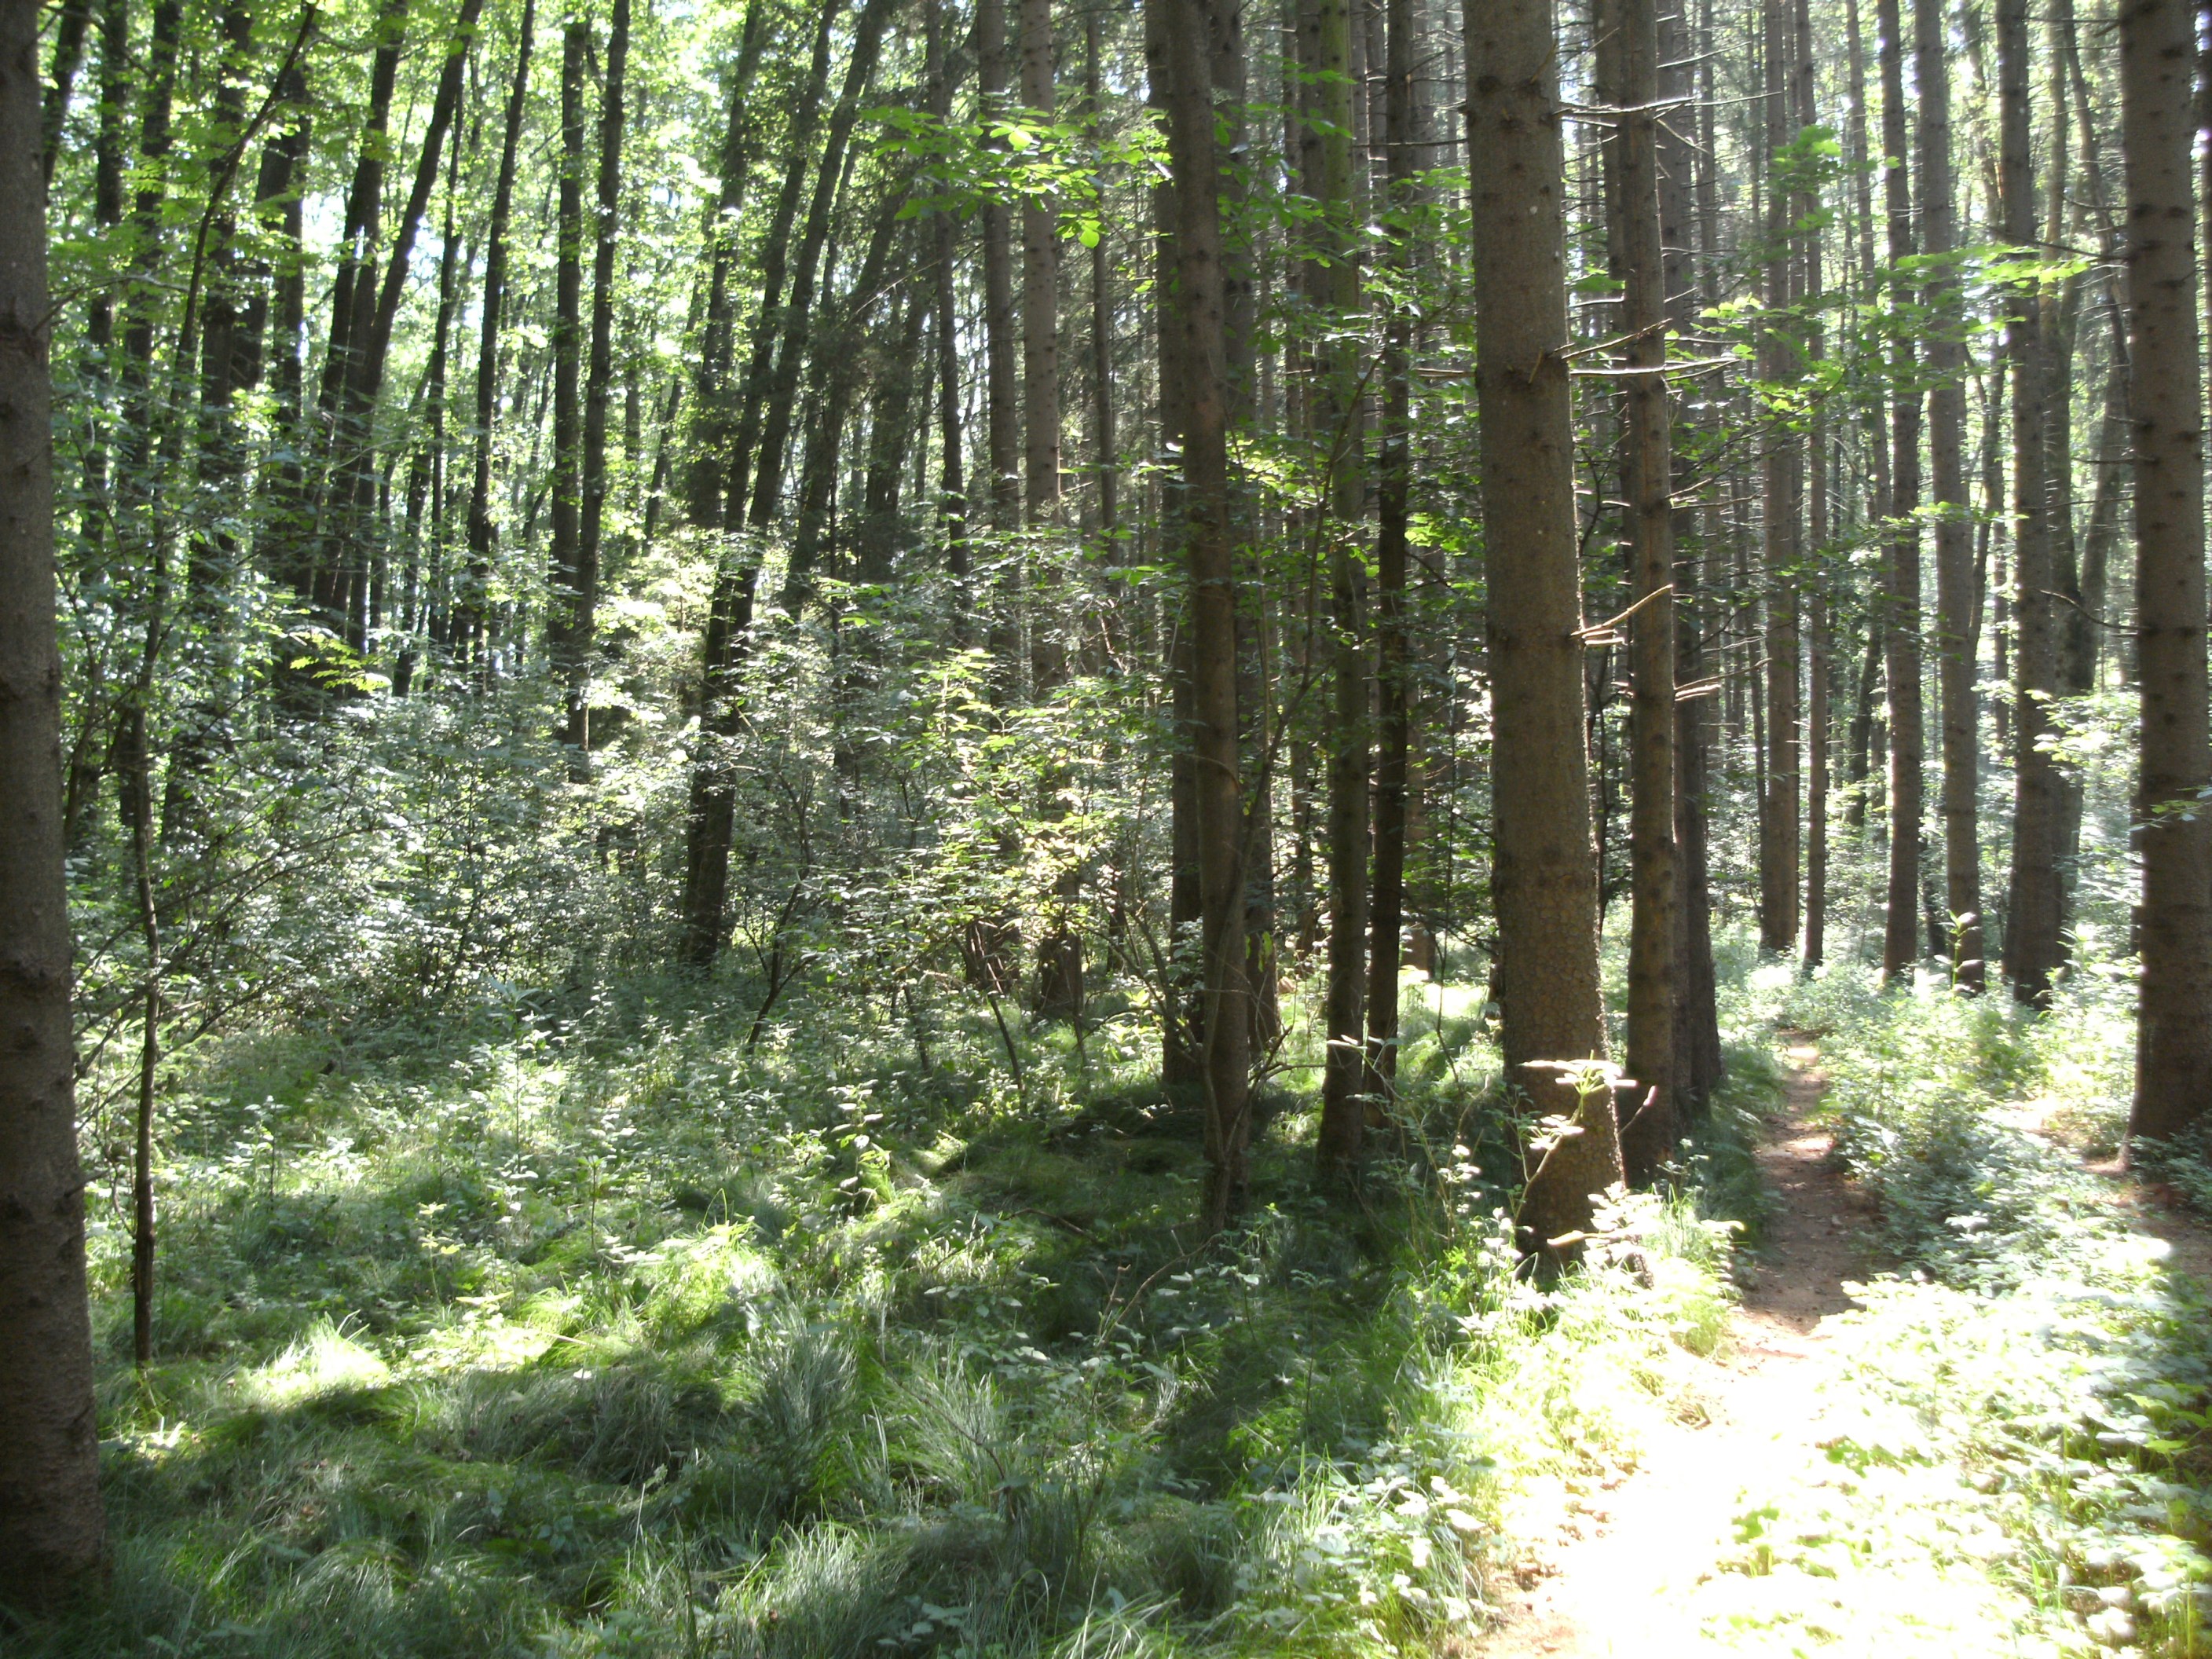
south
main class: Woodland
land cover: Spruce dominated mixed woodland
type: mire and swamp forests
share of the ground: > 75 %
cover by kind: coniferous forest trees 40 %, broadleaved forest trees 35 %, shrubs 15 %, herbaceous plants 10 %
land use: Forestry
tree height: > 5 m
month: July
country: AT
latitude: 46.6887
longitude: 14.9277
